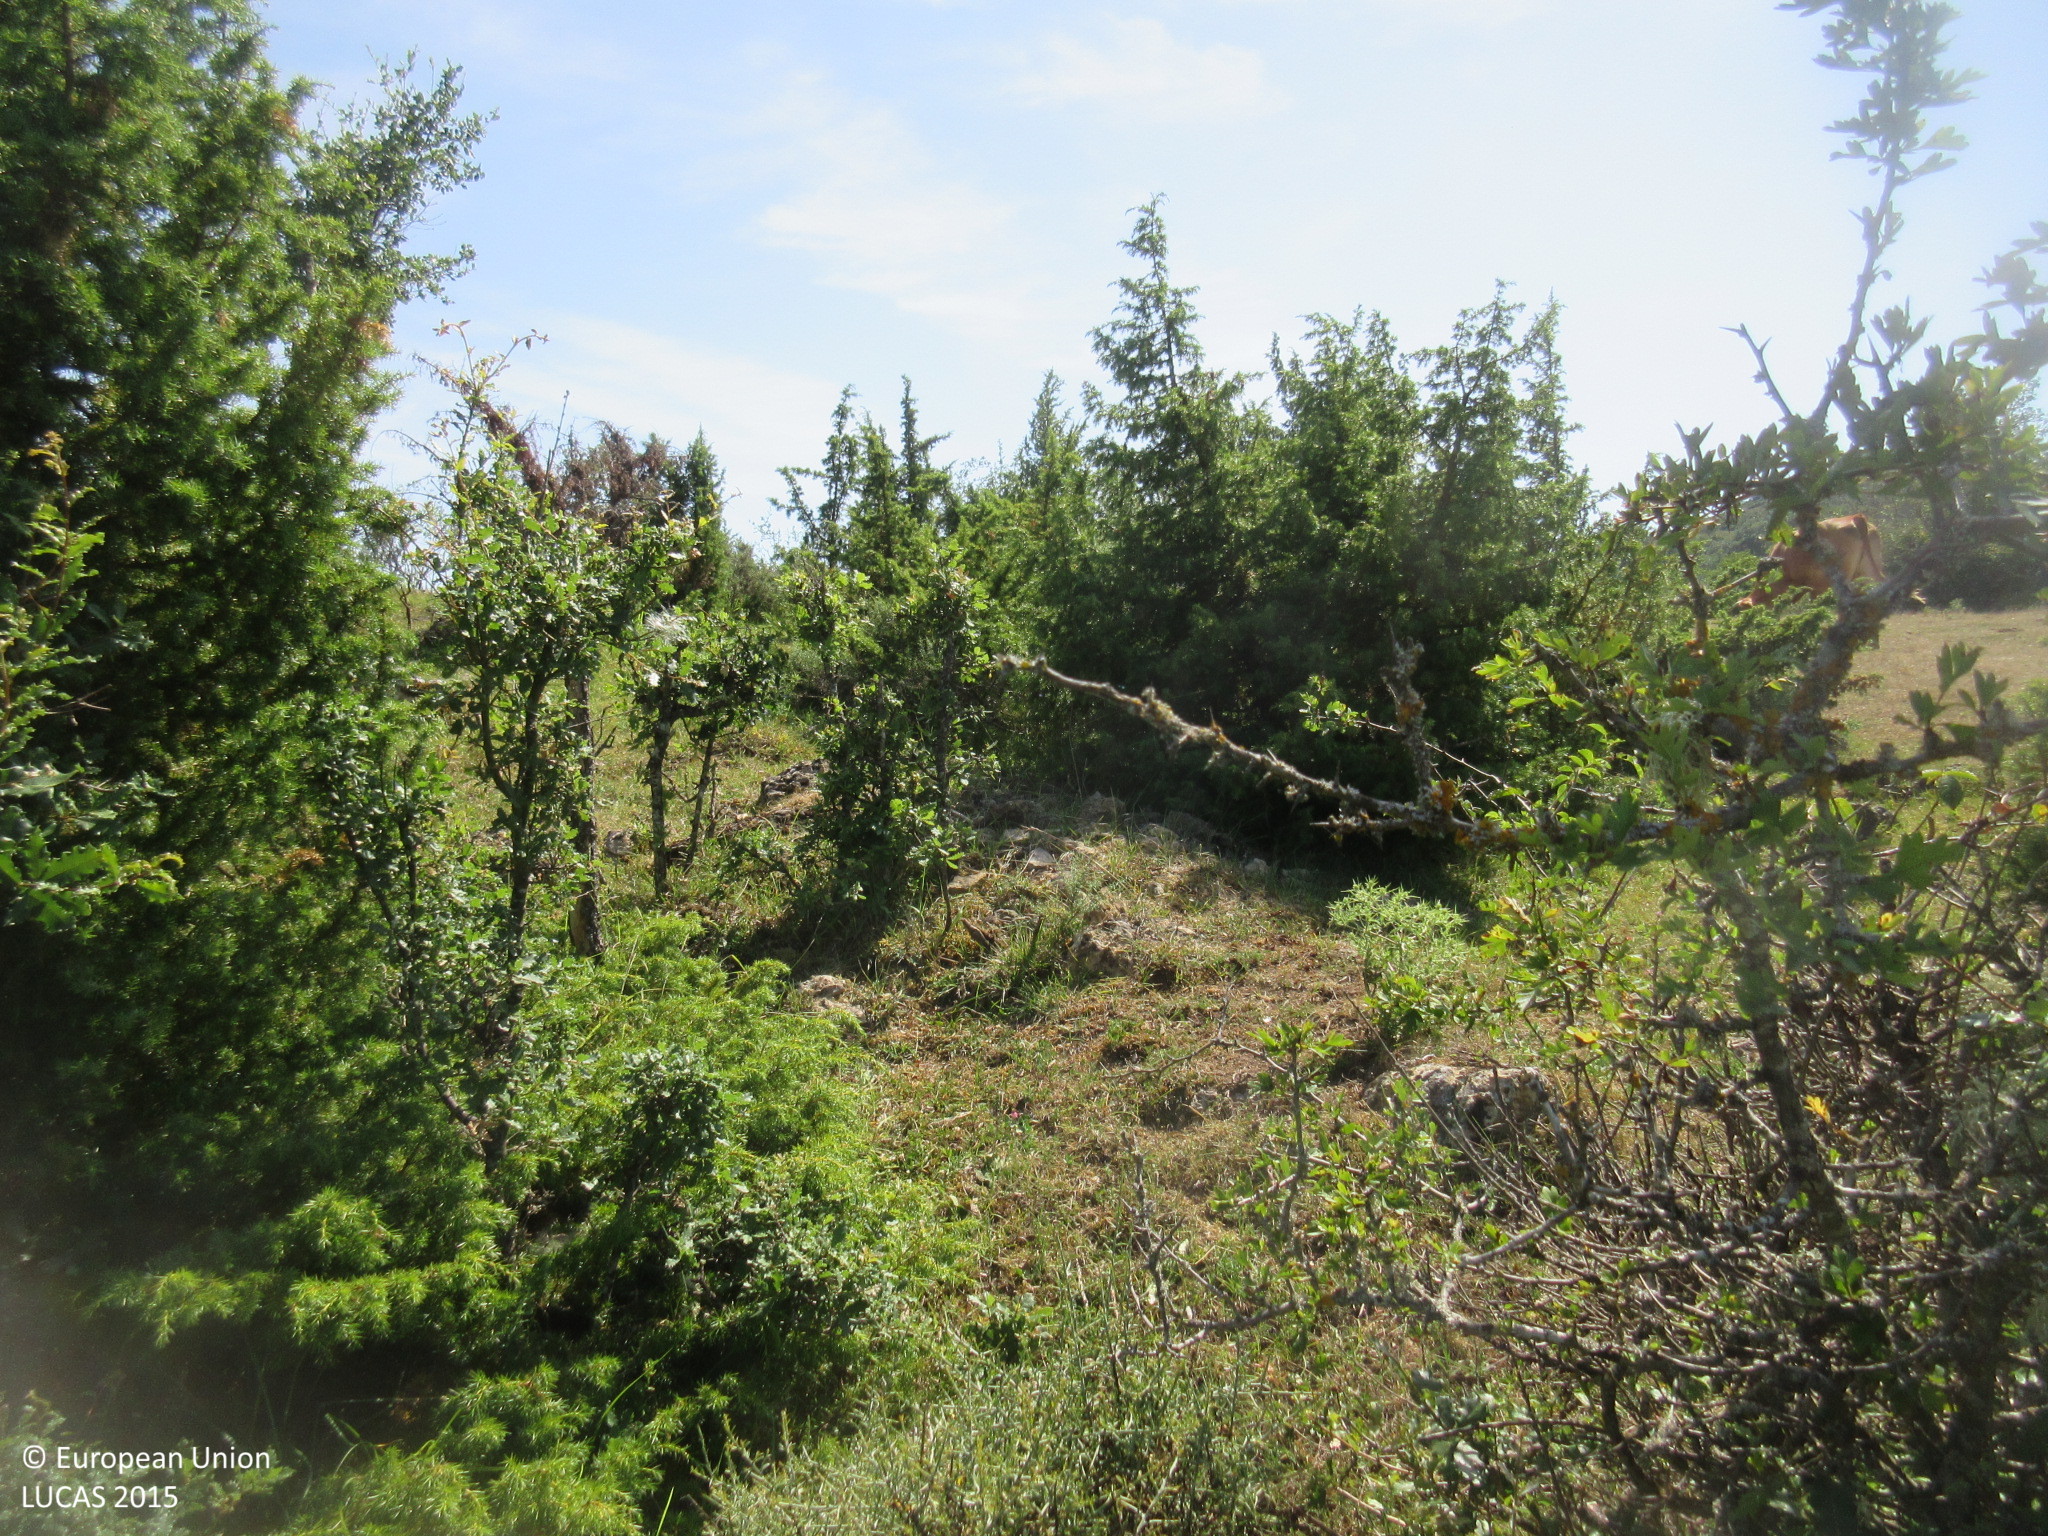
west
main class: Grassland
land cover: Grassland with sparse tree/shrub cover
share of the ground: > 75 %
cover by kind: herbaceous plants 90 %, broadleaved forest trees 5 %, shrubs 5 %
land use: Agriculture (excluding fallow land and kitchen gardens)
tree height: > 5 m
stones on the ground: 10 - 25 %
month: July
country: ES
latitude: 42.9427
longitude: -3.4334
